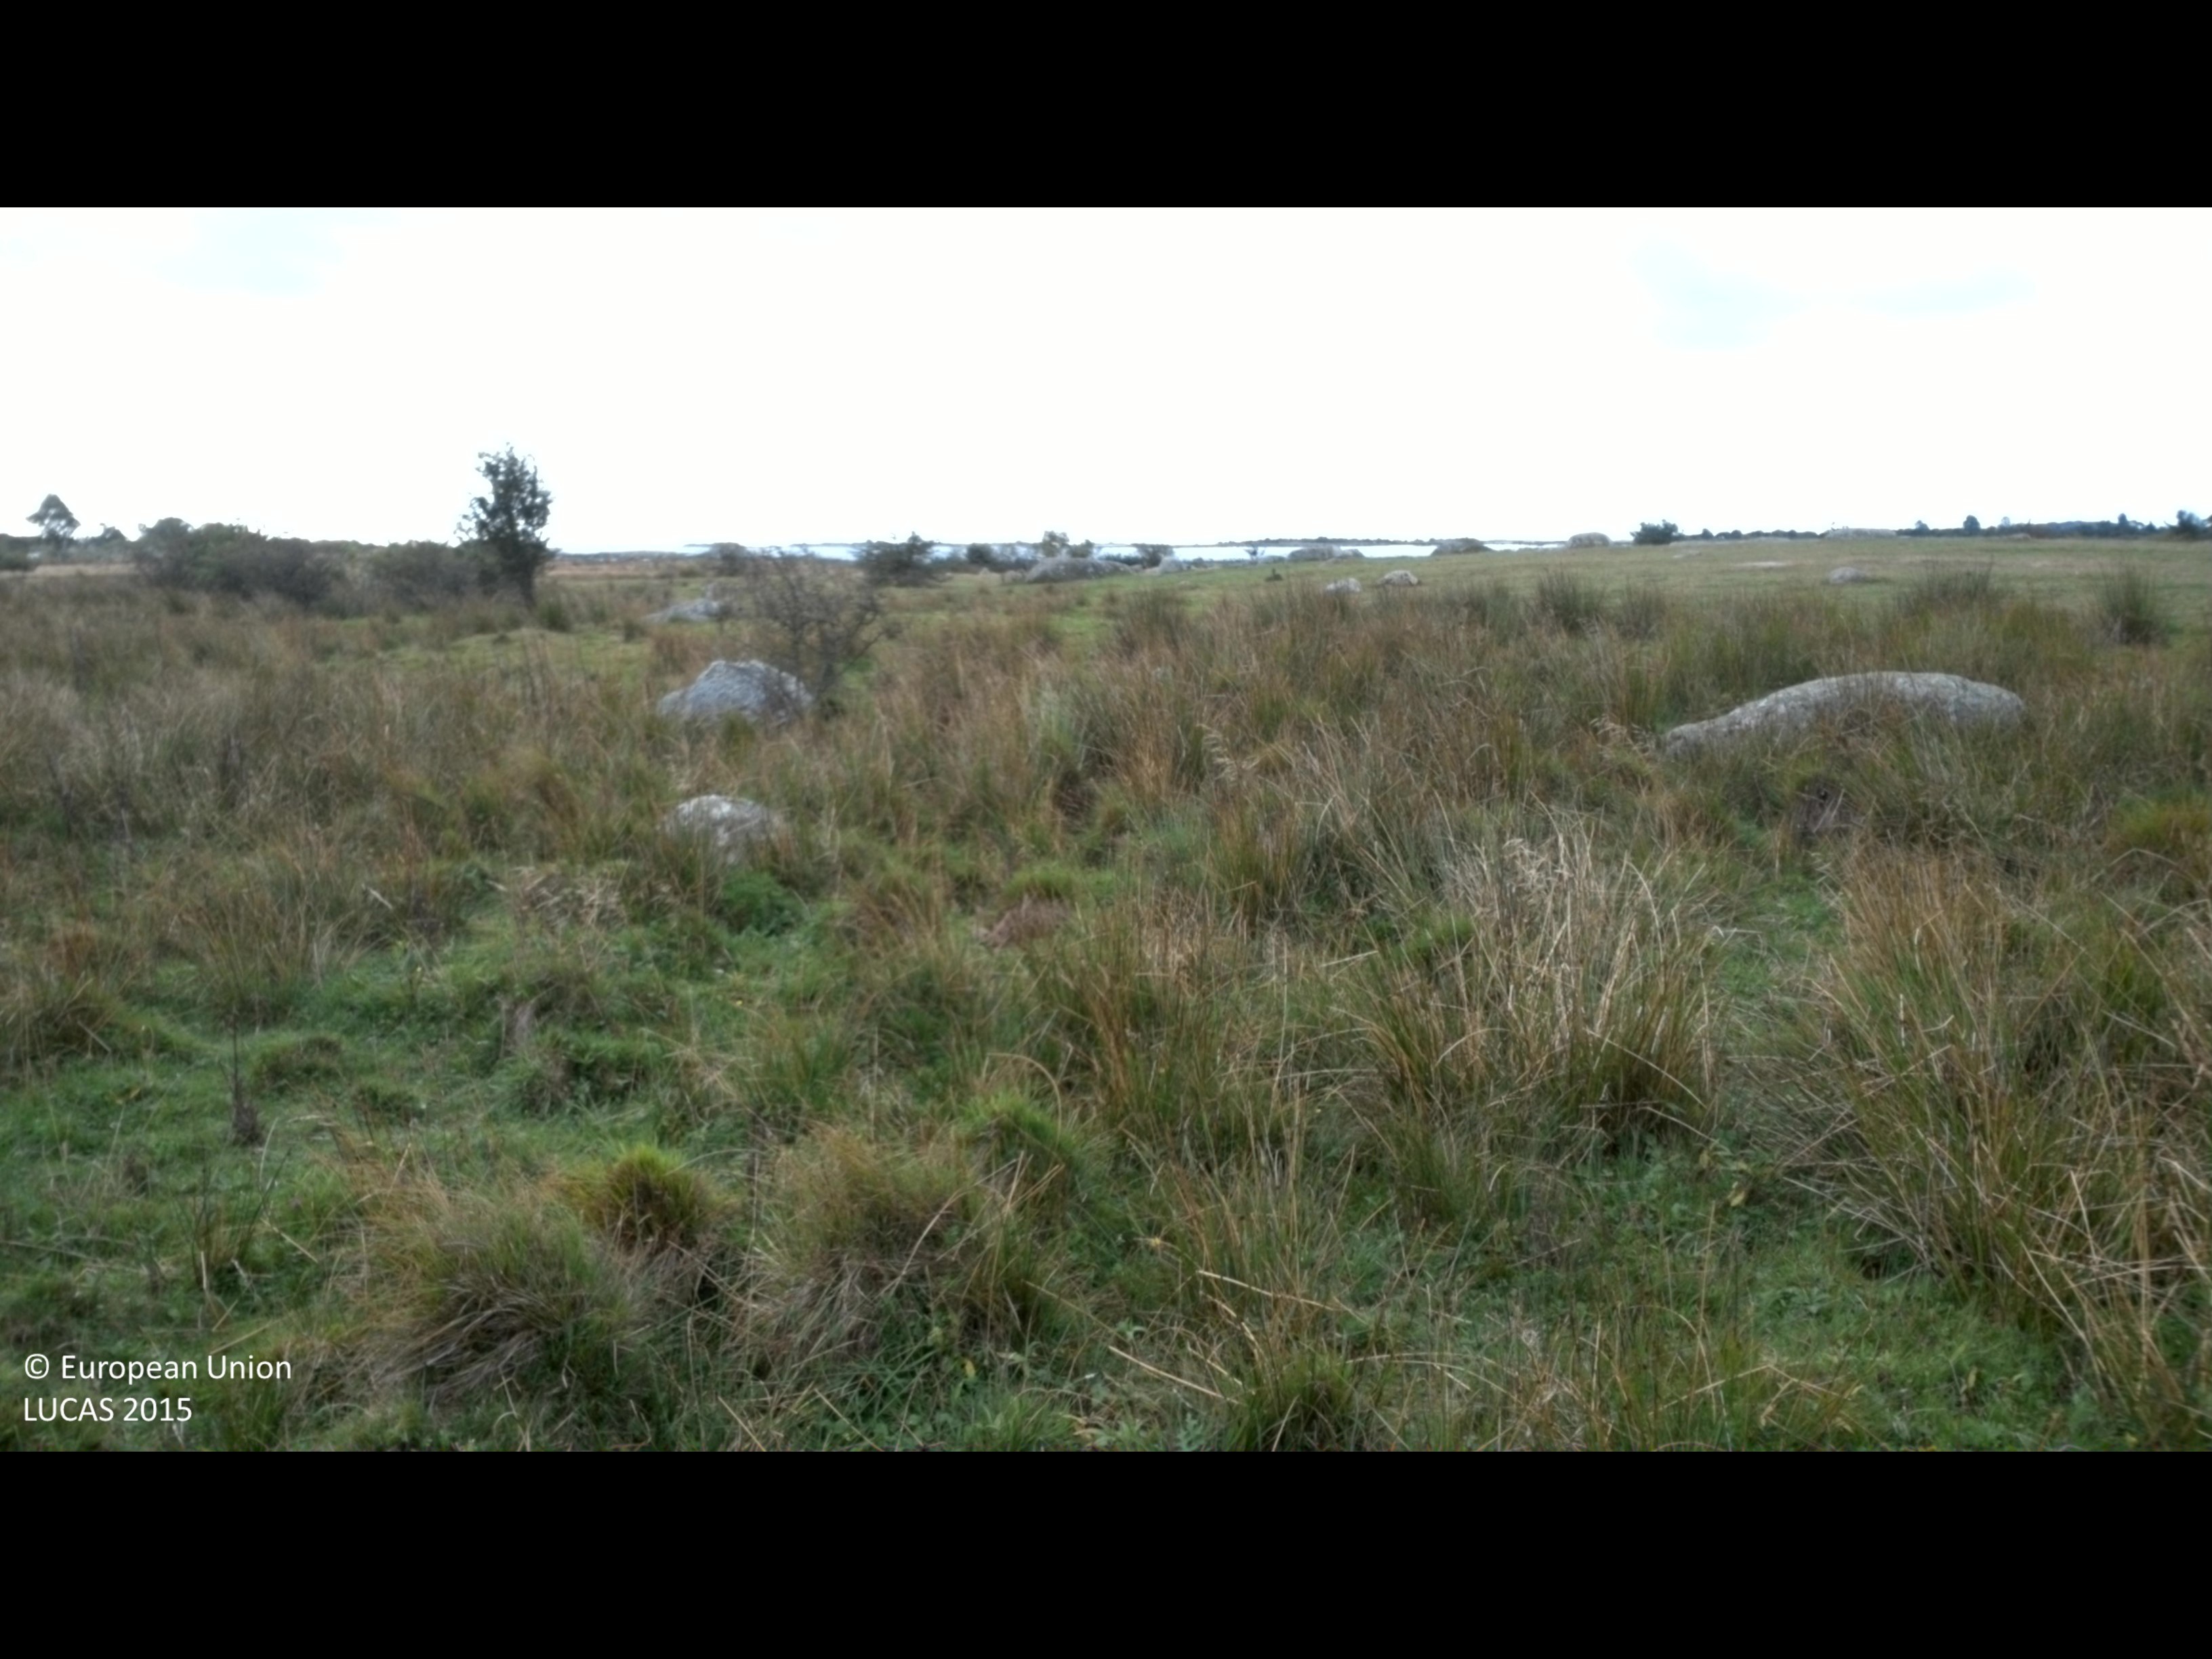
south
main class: Grassland
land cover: Grassland without tree/shrub cover
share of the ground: > 75 %
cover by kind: herbaceous plants 100 %
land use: Agriculture (excluding fallow land and kitchen gardens)
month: September
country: SE
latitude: 56.0030
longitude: 14.4402
